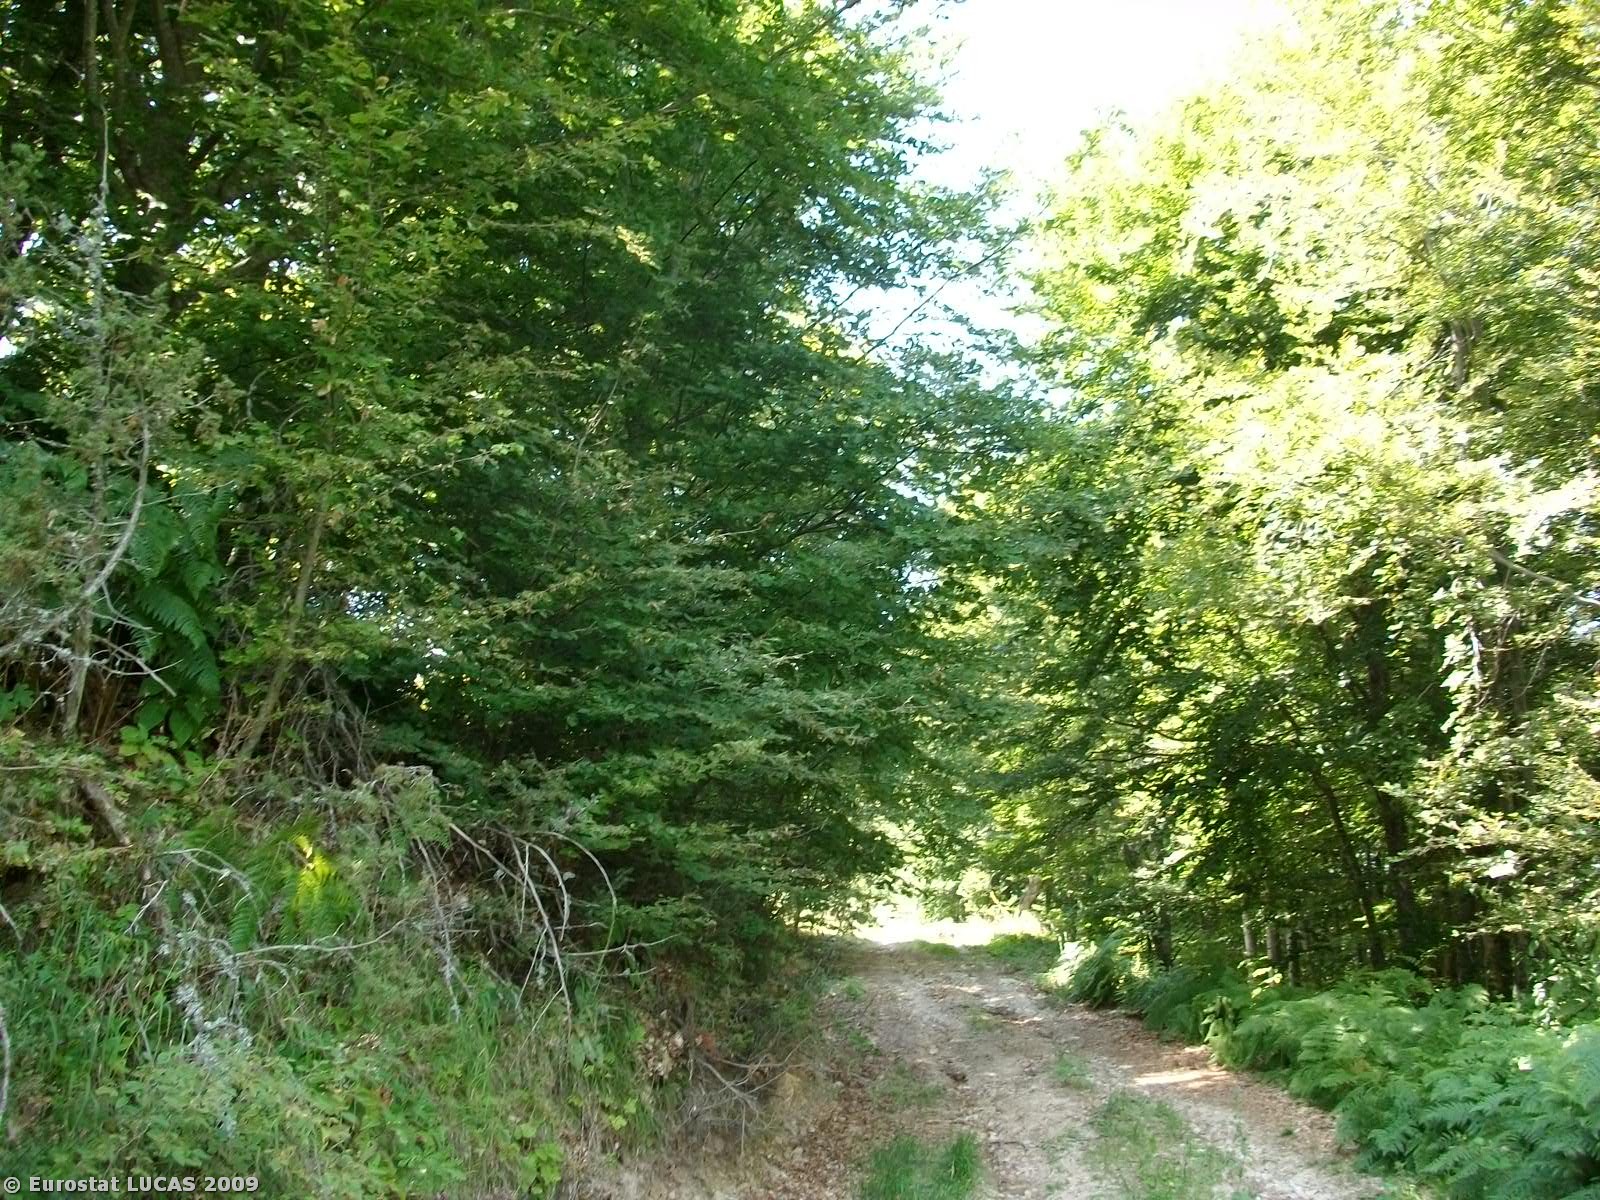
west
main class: Woodland
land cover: Broadleaved woodland
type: beech forest
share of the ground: > 75 %
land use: Forestry
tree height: > 5 m
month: August
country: GR
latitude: 41.2987
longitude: 24.2080
